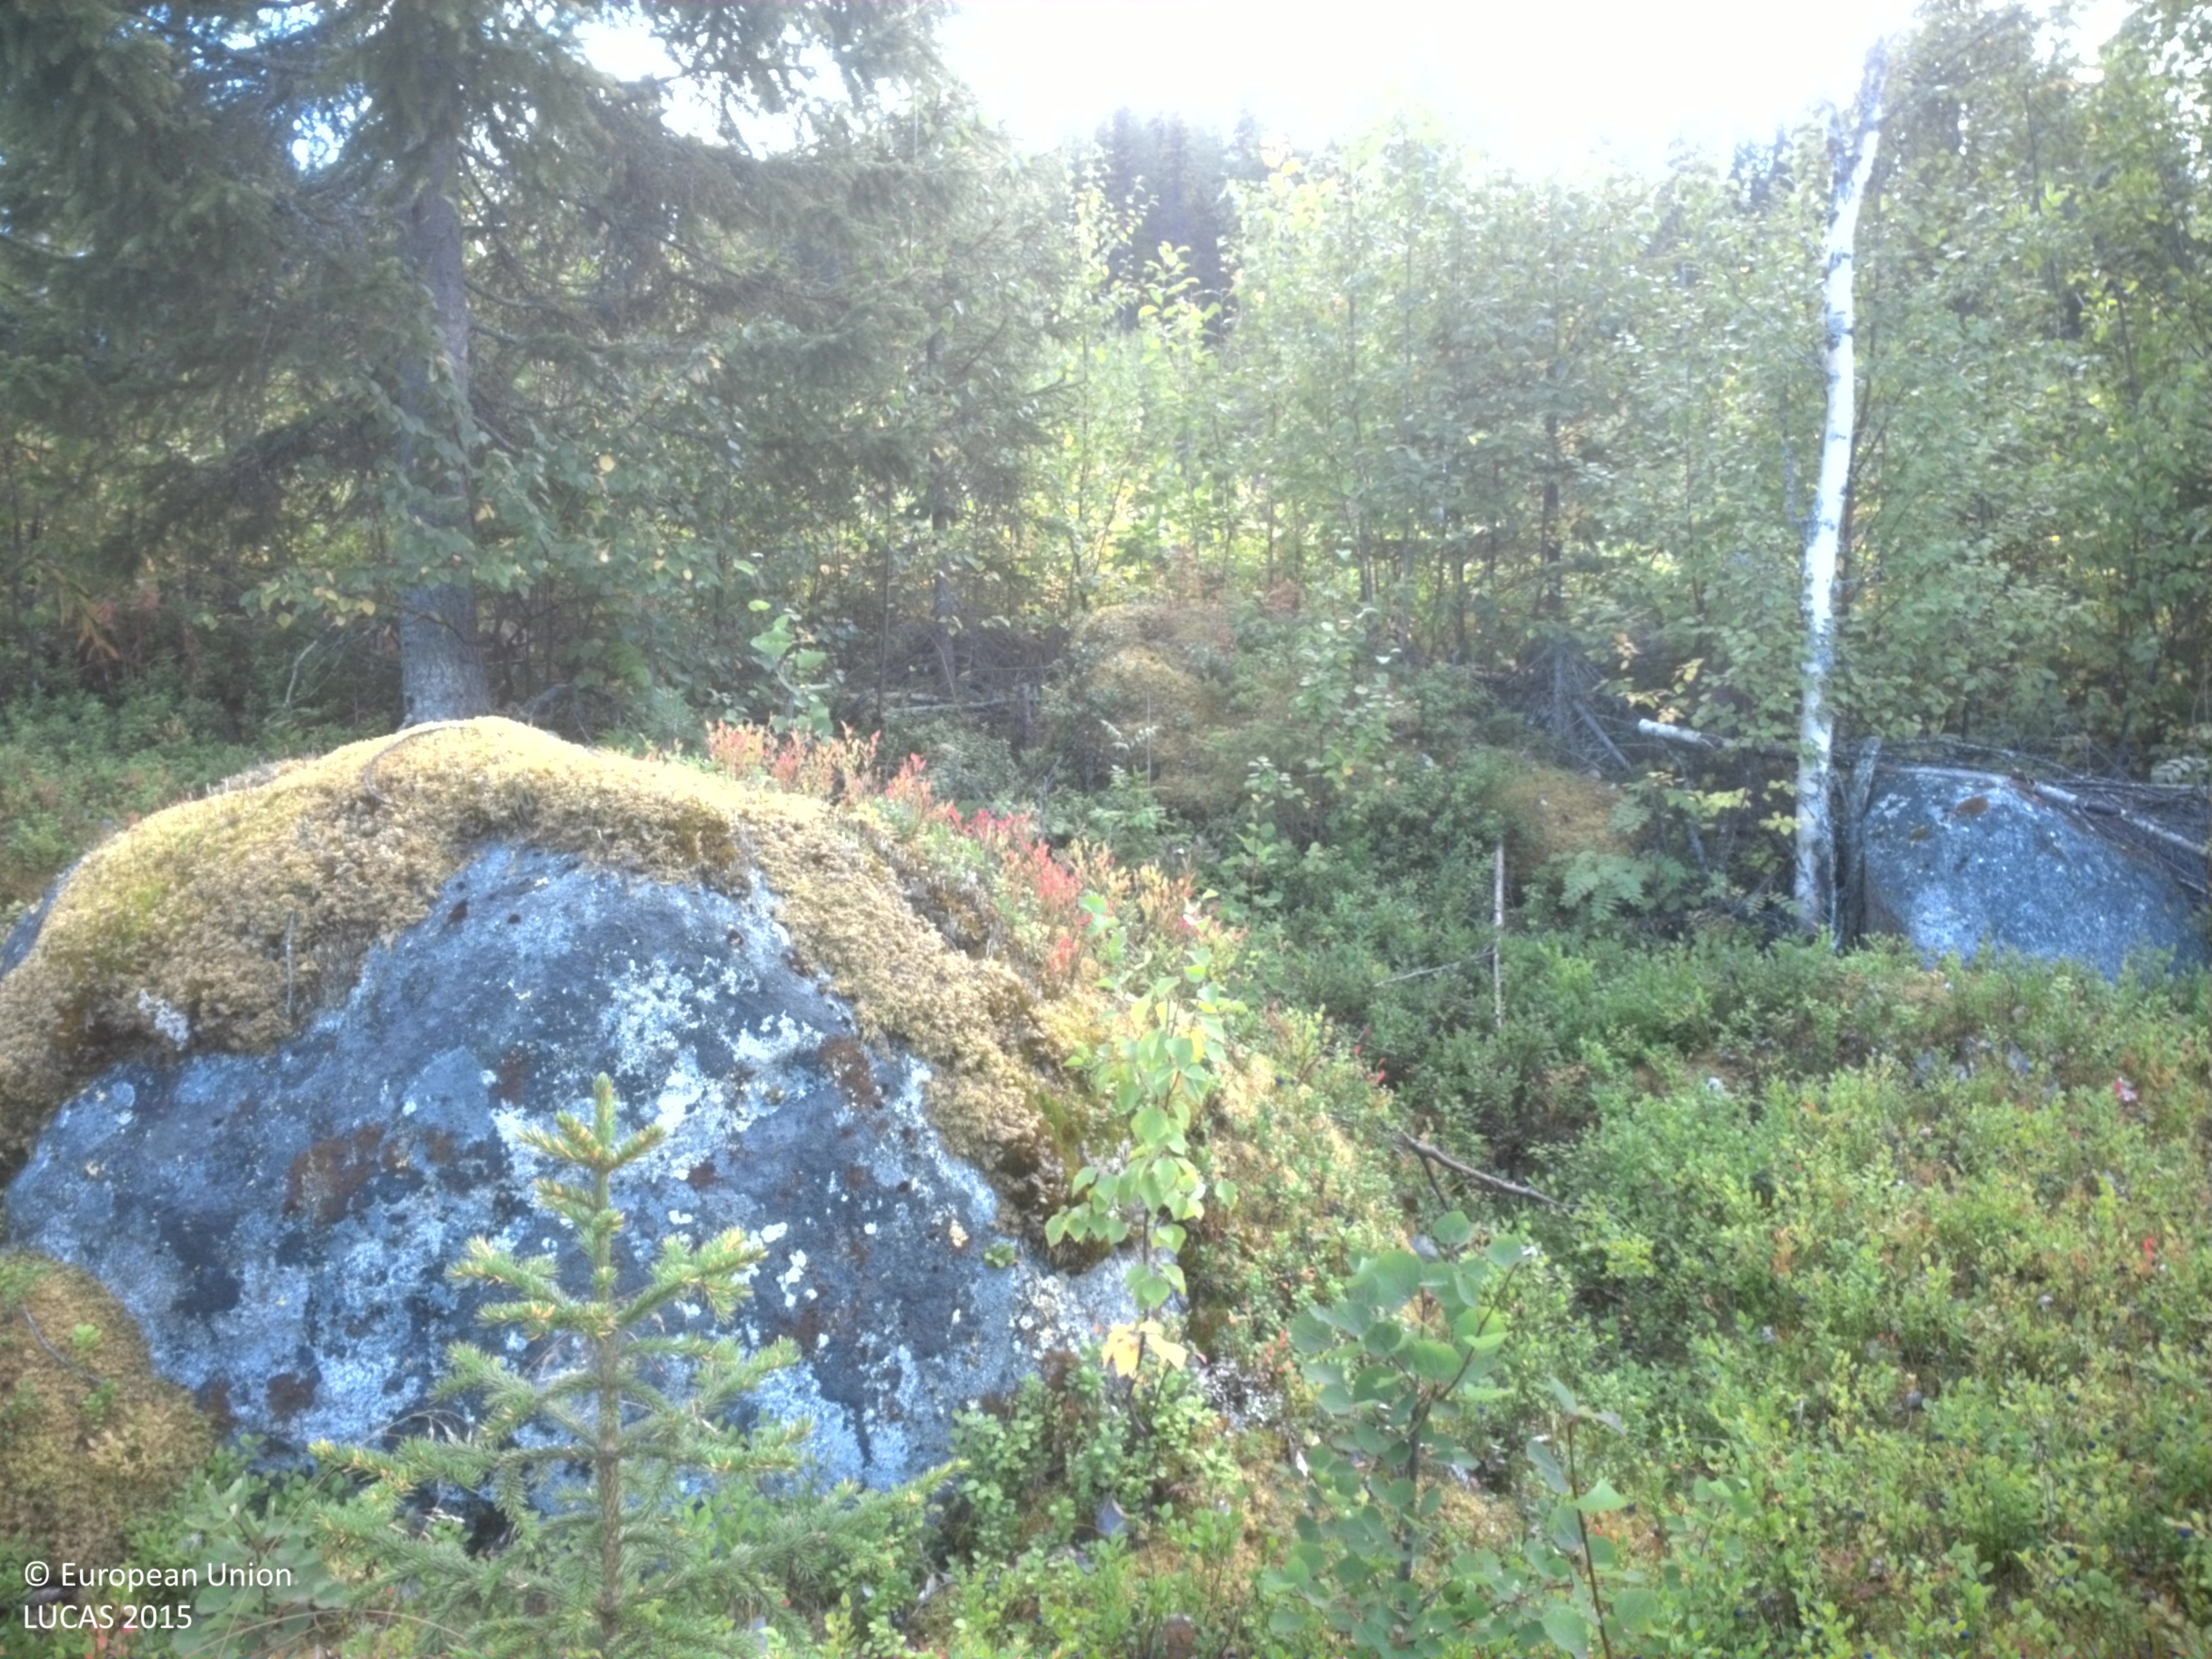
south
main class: Woodland
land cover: Broadleaved woodland
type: boreal forest
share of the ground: 50 - 75 %
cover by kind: broadleaved forest trees 60 %, shrubs 15 %, coniferous forest trees 10 %, lichens and mosses 10 %, herbaceous plants 5 %
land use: Forestry
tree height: > 5 m
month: September
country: SE
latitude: 64.4309
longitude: 19.0452
